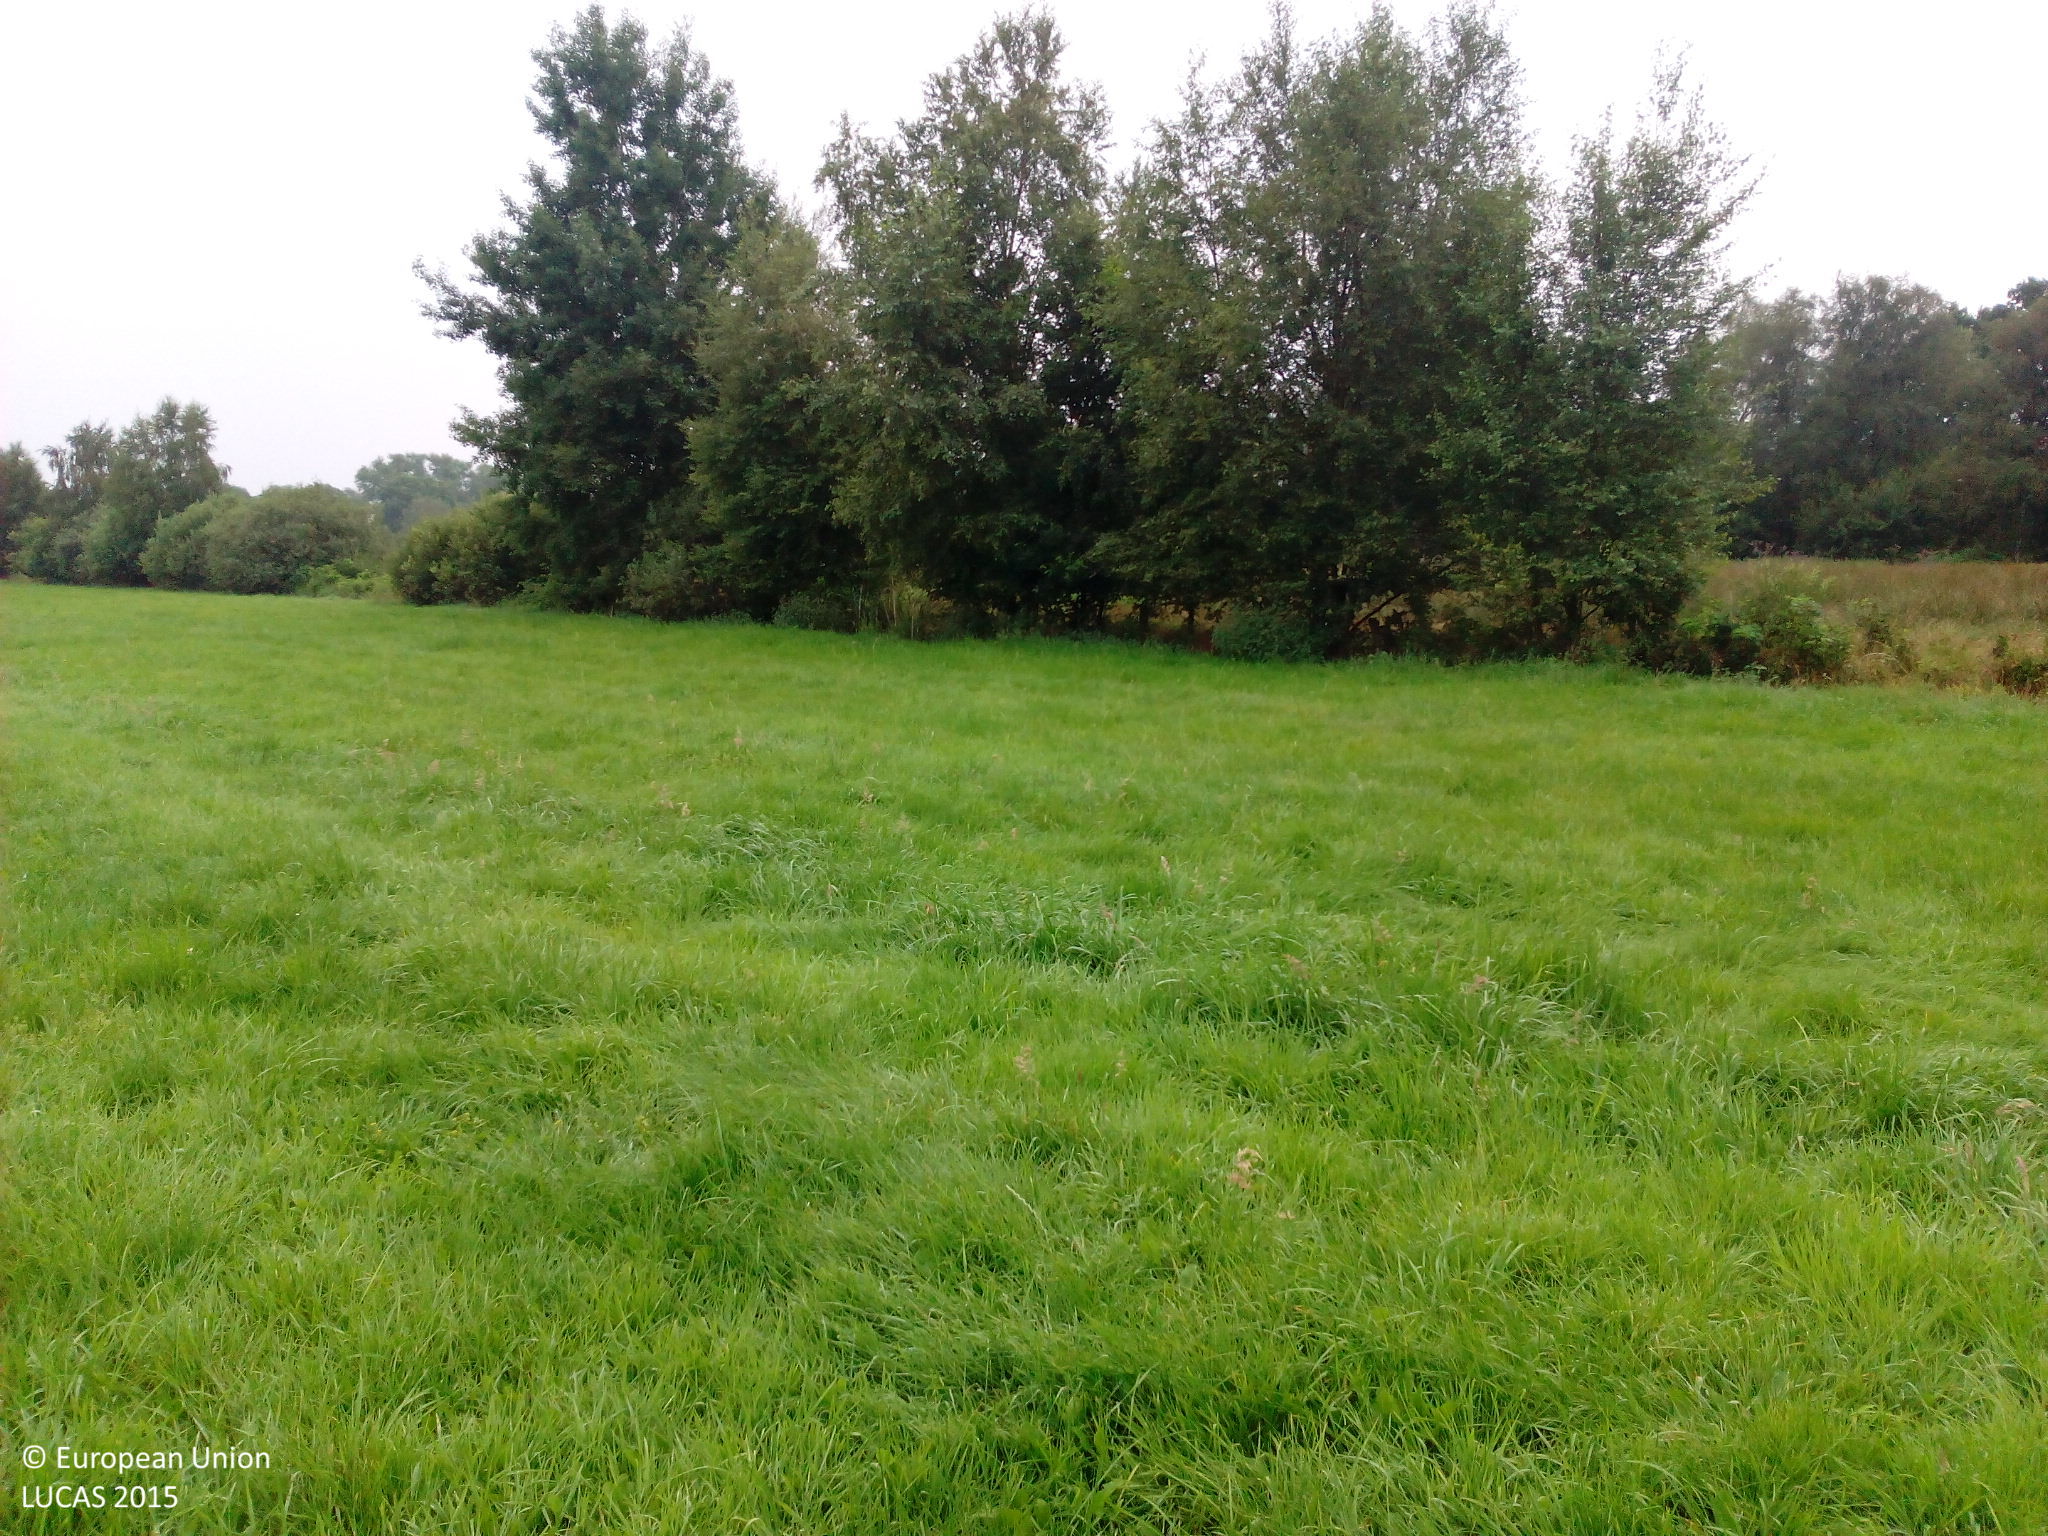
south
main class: Grassland
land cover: Grassland without tree/shrub cover
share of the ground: > 75 %
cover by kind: herbaceous plants 100 %
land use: Agriculture (excluding fallow land and kitchen gardens)
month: August
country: DE
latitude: 53.8687
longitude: 9.6504
